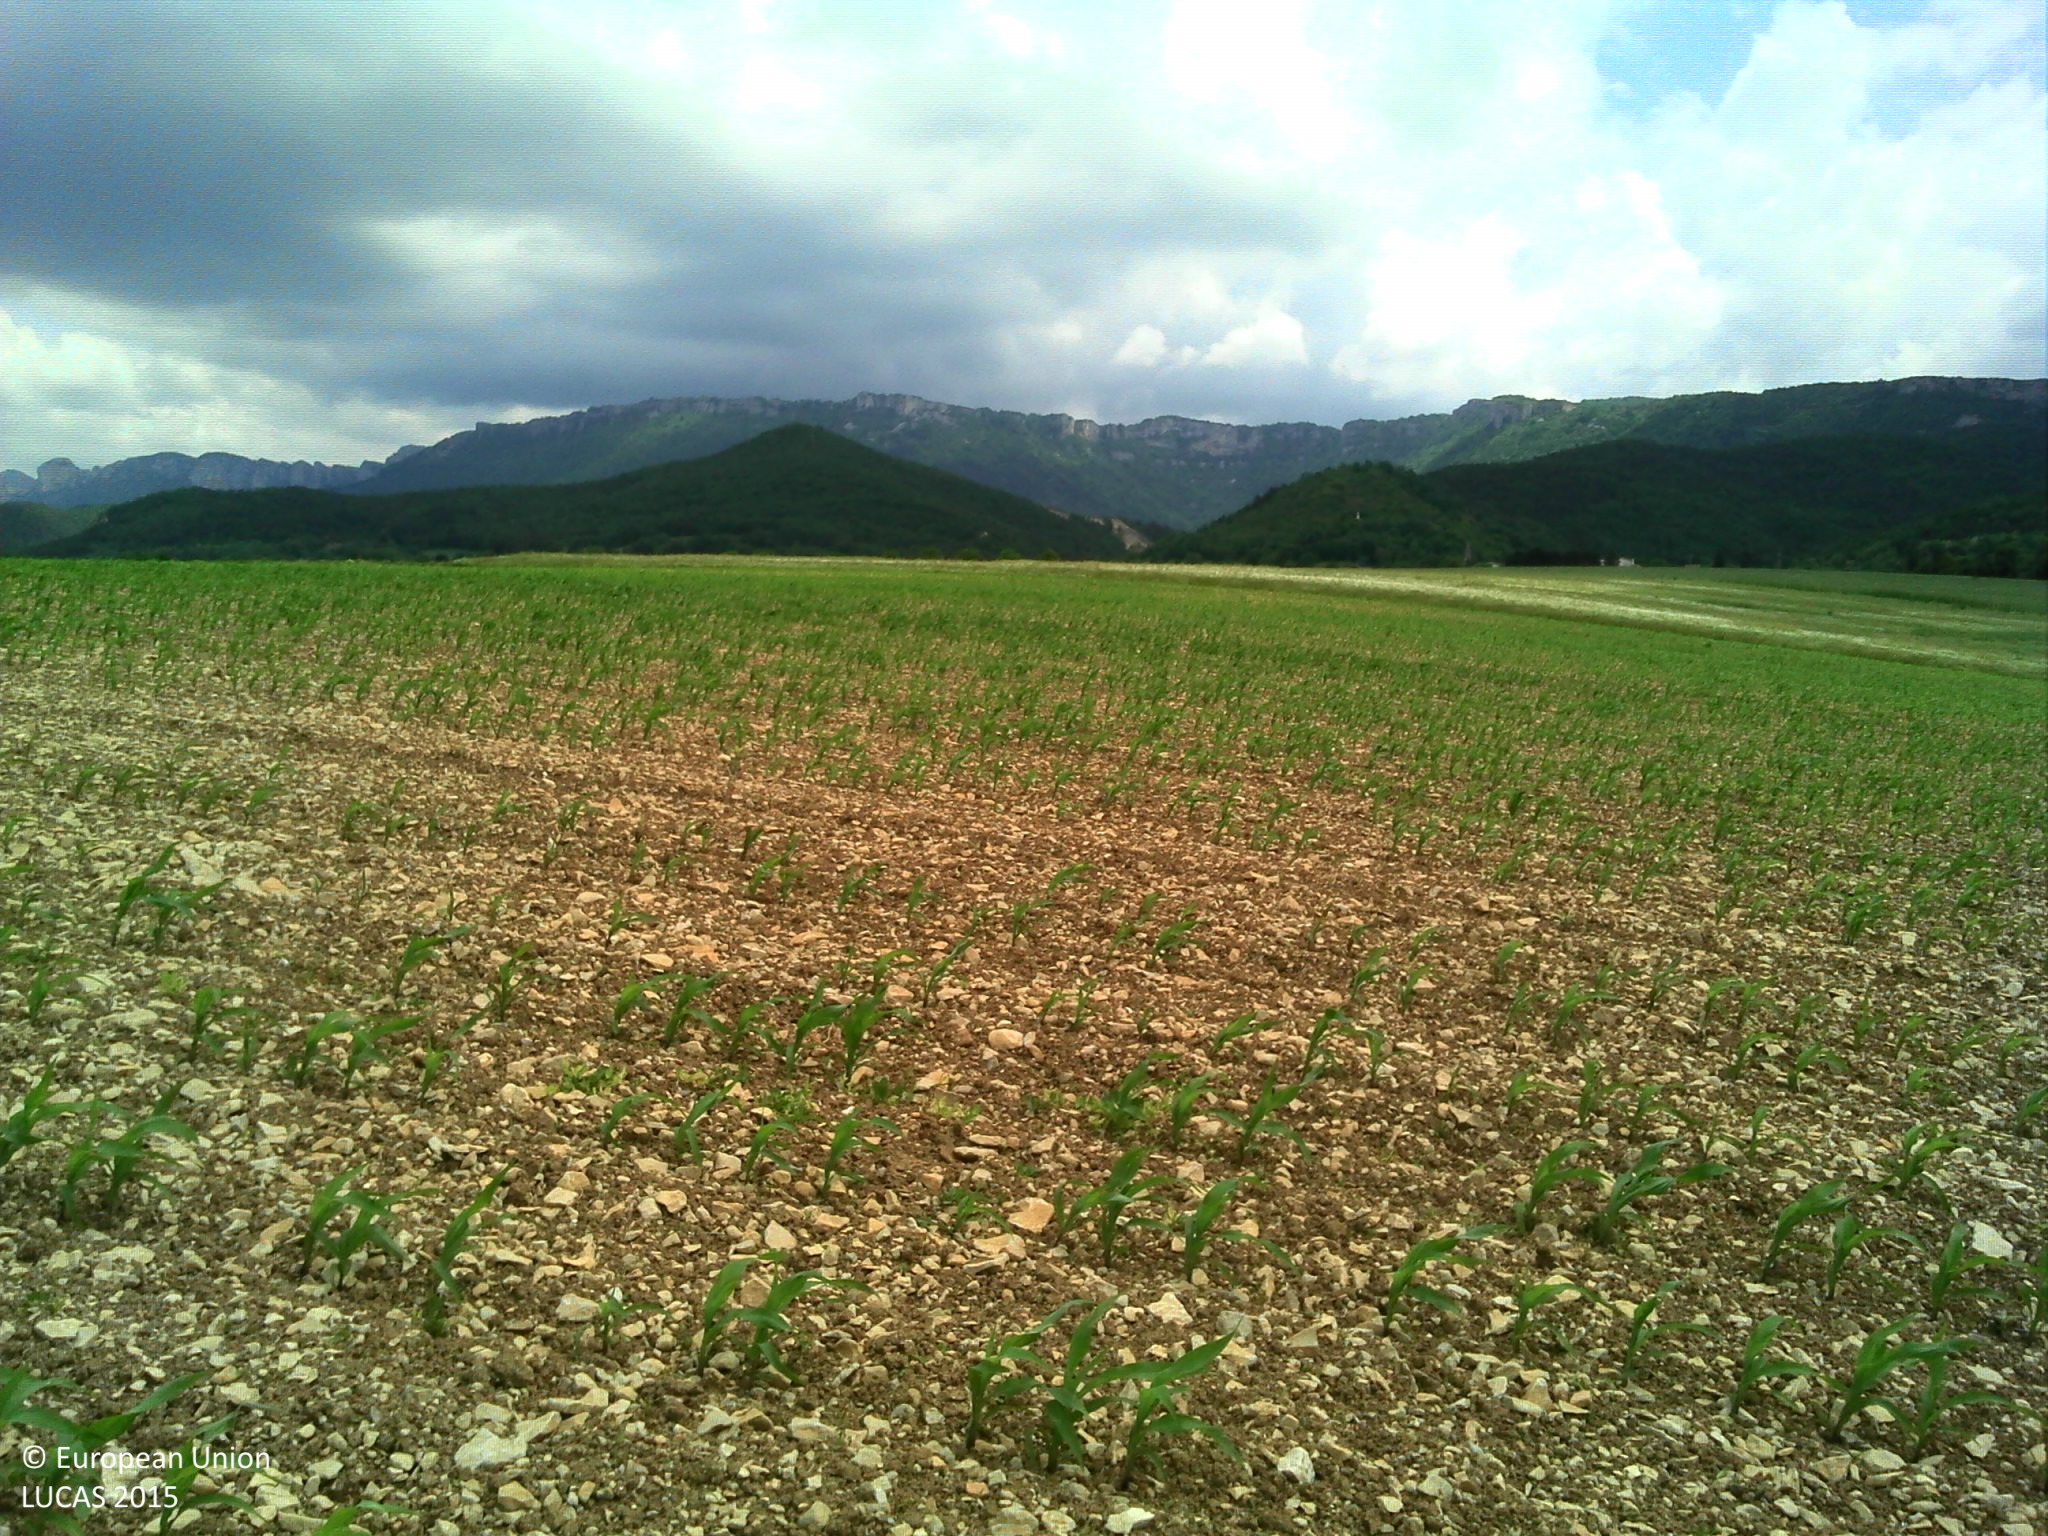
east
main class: Cropland
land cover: Maize
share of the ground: 50 - 75 %
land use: Agriculture (excluding fallow land and kitchen gardens)
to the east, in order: Maize; Rape and turnip rape; Tracks; Other leguminous and mixtures for fodder
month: May
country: FR
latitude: 44.9022
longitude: 5.0795
